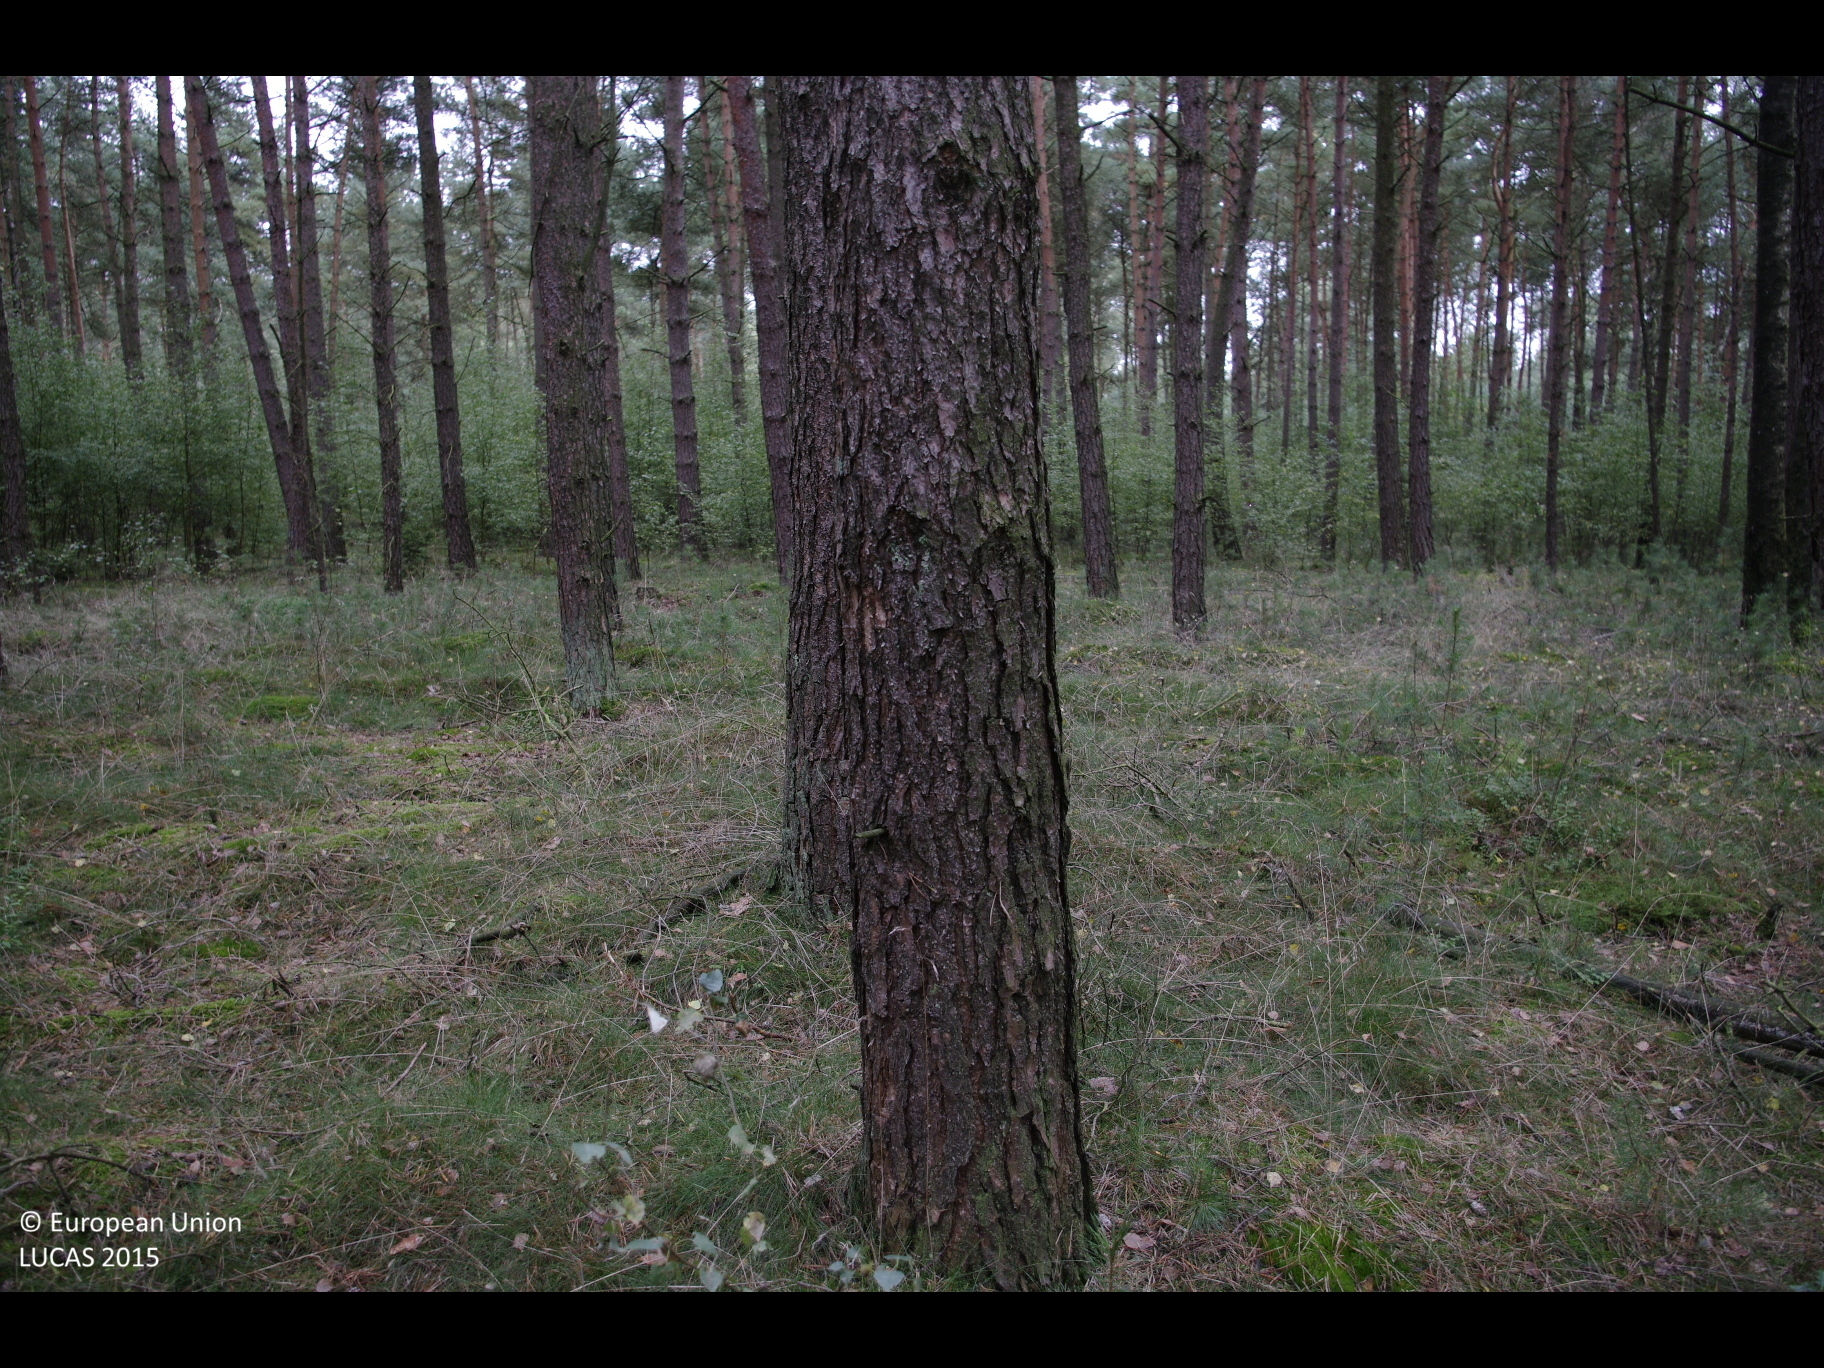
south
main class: Woodland
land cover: Pine dominated mixed woodland
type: hemiboreal forest and nemoral coniferous forest and mixed broadleaved-coniferous forest
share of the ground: 50 - 75 %
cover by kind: coniferous forest trees 40 %, broadleaved forest trees 30 %, herbaceous plants 30 %
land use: Forestry
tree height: > 5 m
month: September
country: DE
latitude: 53.0424
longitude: 9.8658
